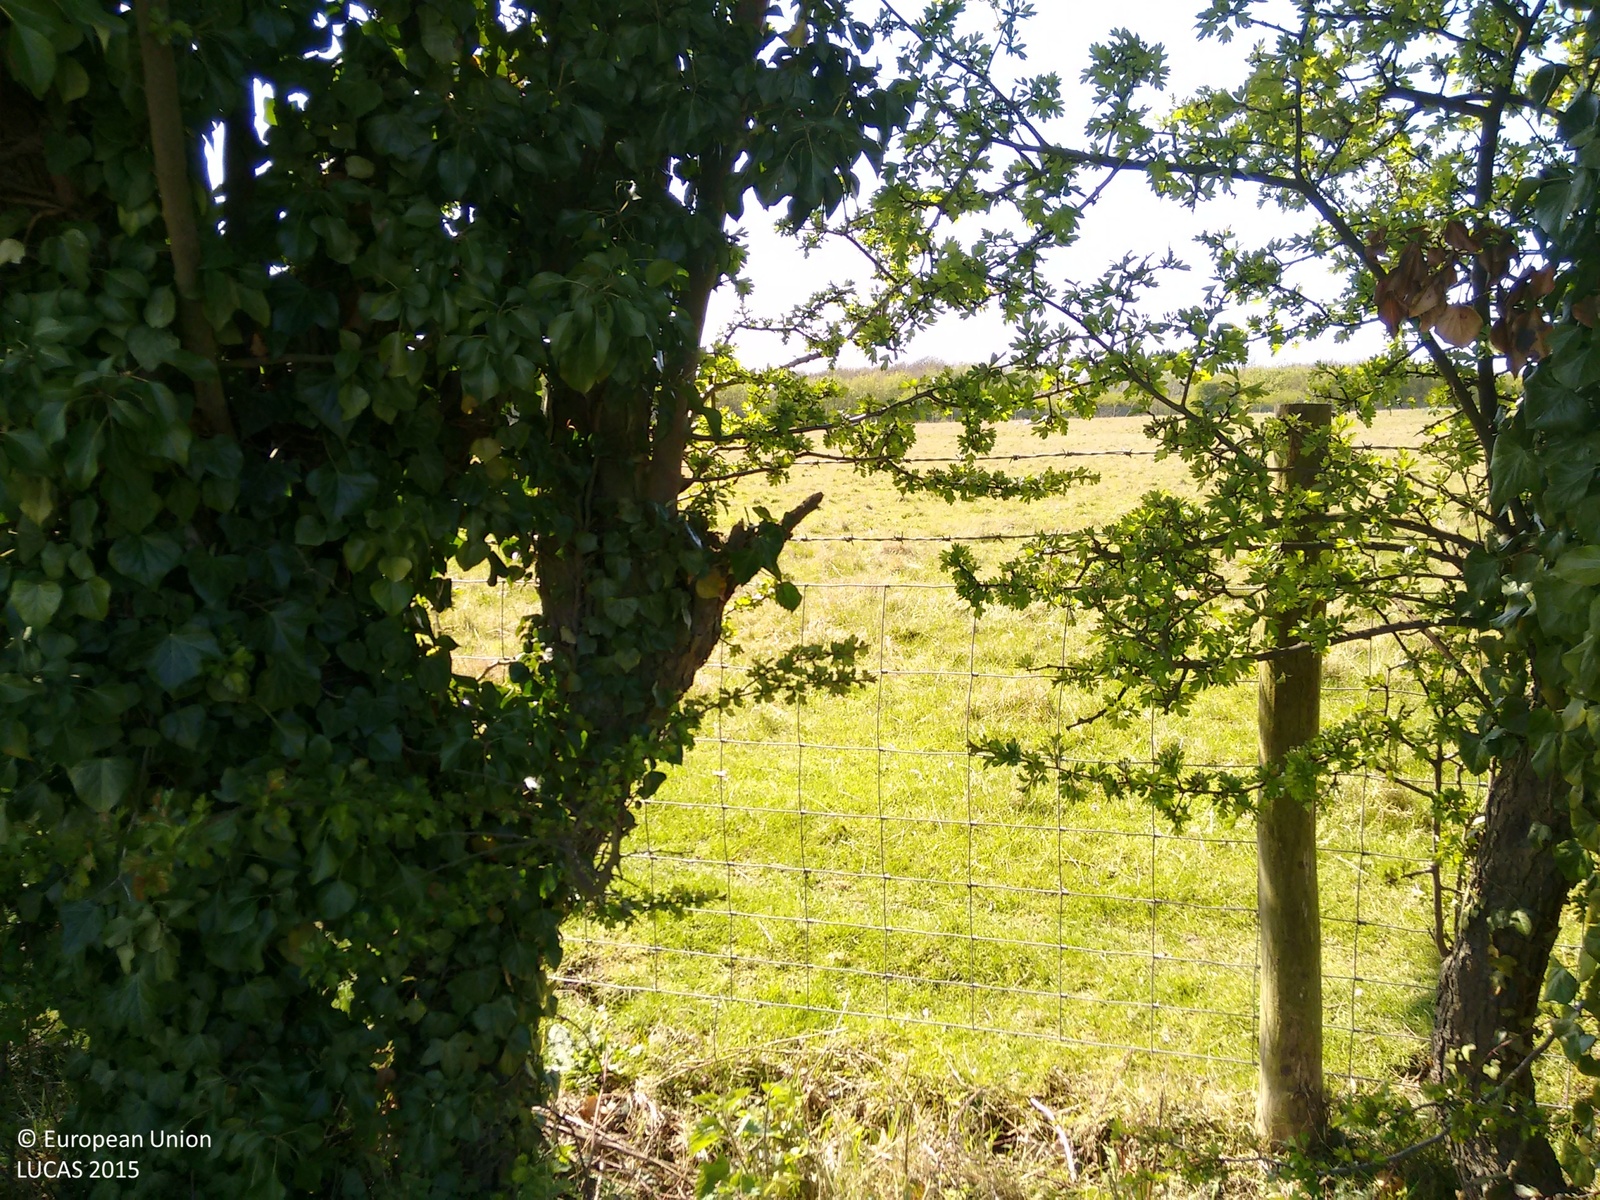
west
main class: Grassland
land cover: Grassland without tree/shrub cover
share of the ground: > 75 %
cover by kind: herbaceous plants 100 %
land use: Agriculture (excluding fallow land and kitchen gardens)
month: April
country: GB
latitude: 51.4385
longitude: 0.5497
